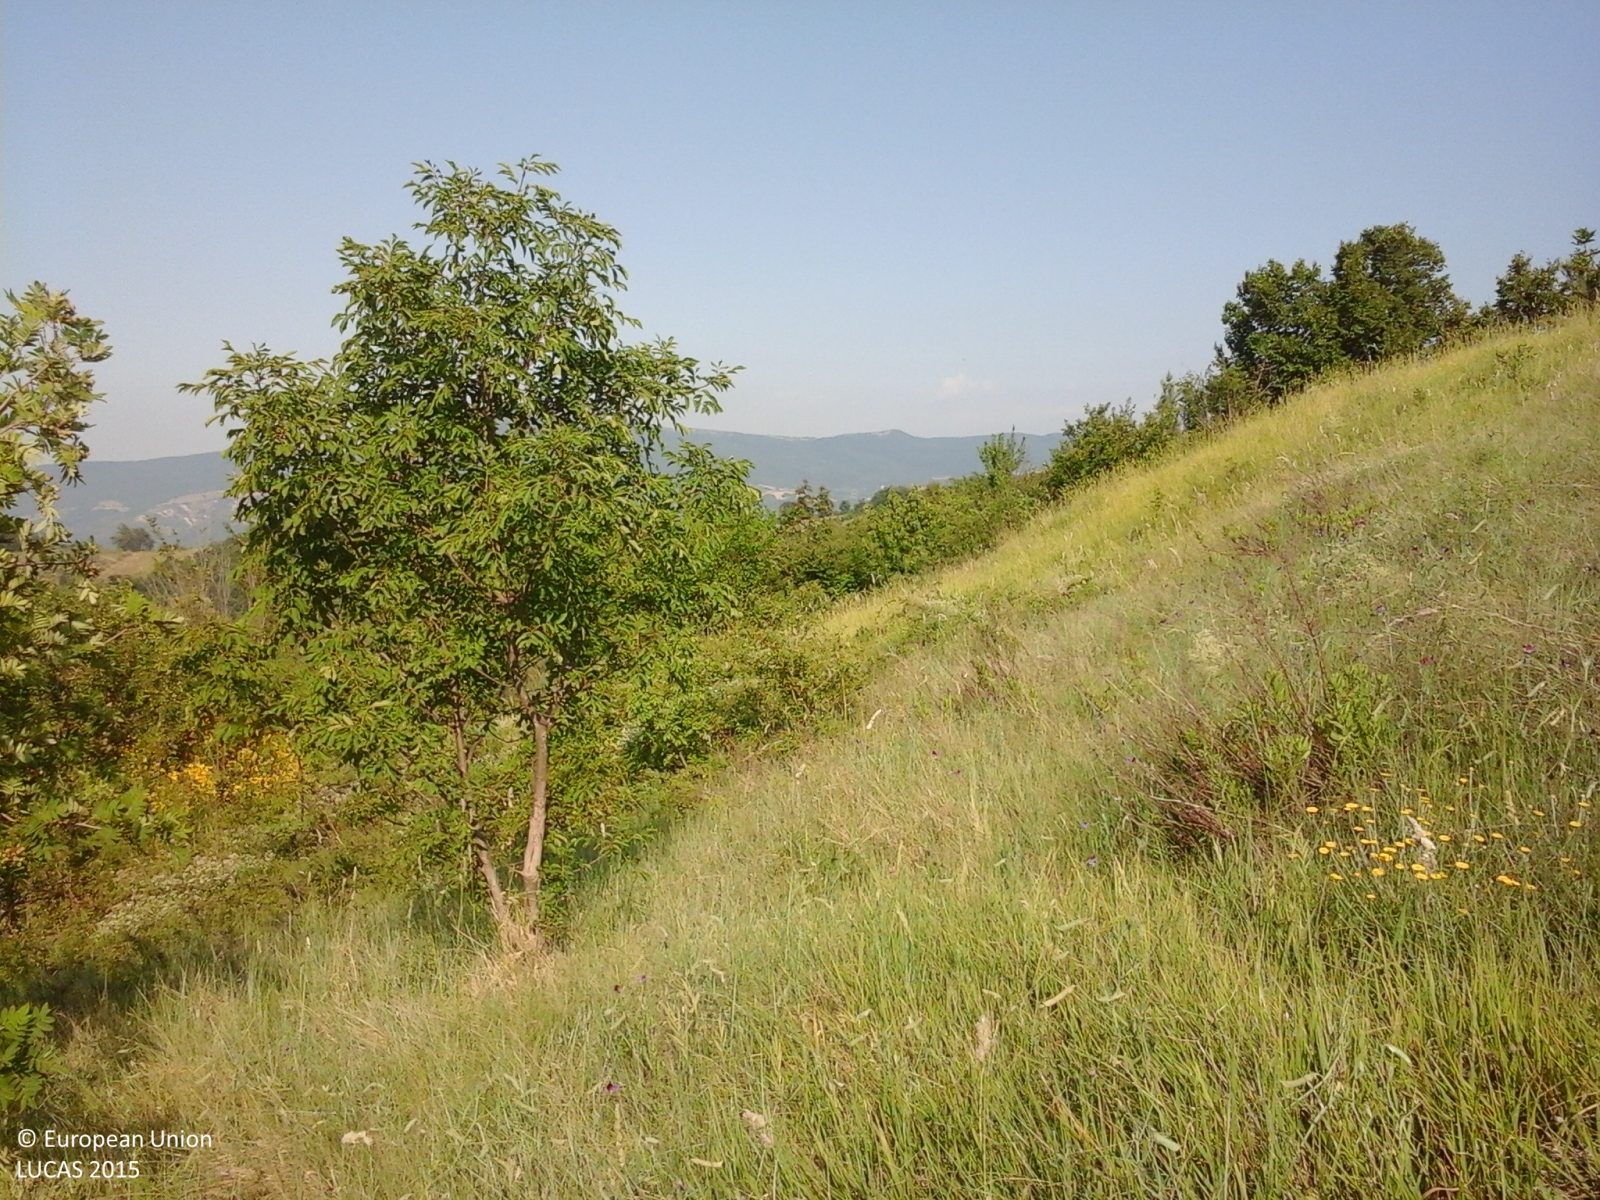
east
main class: Woodland
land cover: Broadleaved woodland
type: thermophilous deciduous forest
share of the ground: > 75 %
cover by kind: broadleaved forest trees 60 %, shrubs 30 %, herbaceous plants 10 %
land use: Semi-natural and natural areas not in use
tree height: < 5 m
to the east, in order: Broadleaved woodland; Shrubland with sparse tree cover; Broadleaved woodland; Grassland without tree/shrub cover; Tracks; Other leguminous and mixtures for fodder; Shrubland without tree cover; Other leguminous and mixtures for fodder
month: June
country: IT
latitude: 42.0382
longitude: 14.2987
